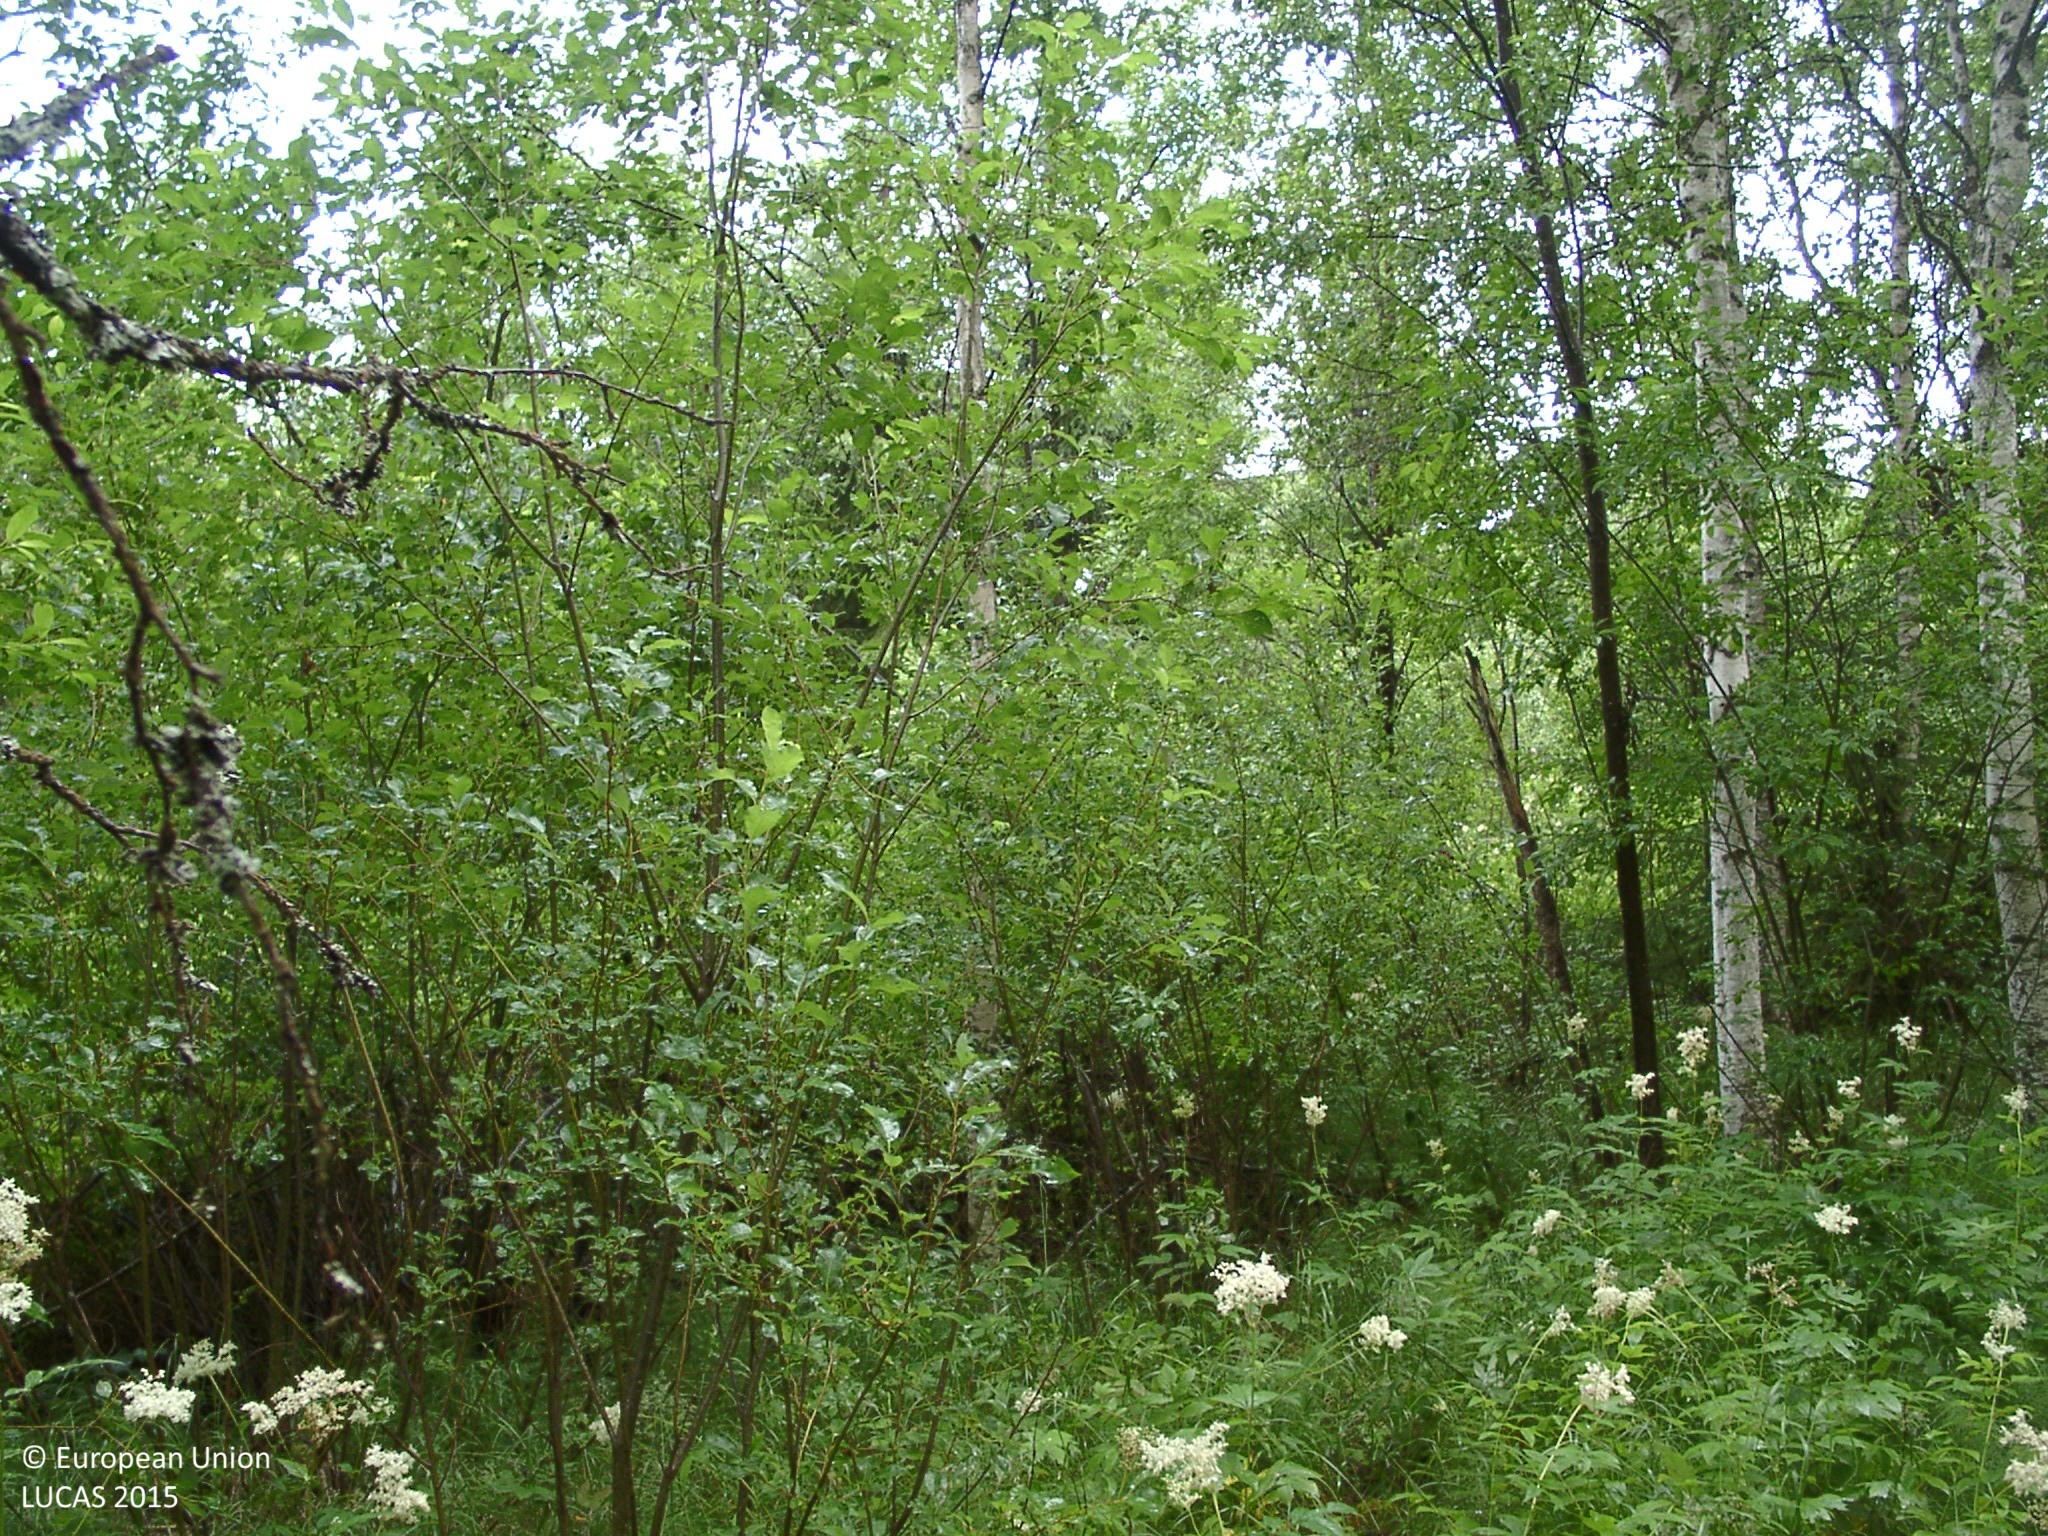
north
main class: Woodland
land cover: Broadleaved woodland
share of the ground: 50 - 75 %
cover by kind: broadleaved forest trees 60 %, herbaceous plants 30 %, shrubs 10 %
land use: Semi-natural and natural areas not in use
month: July
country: FI
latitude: 62.2512
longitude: 25.6152
